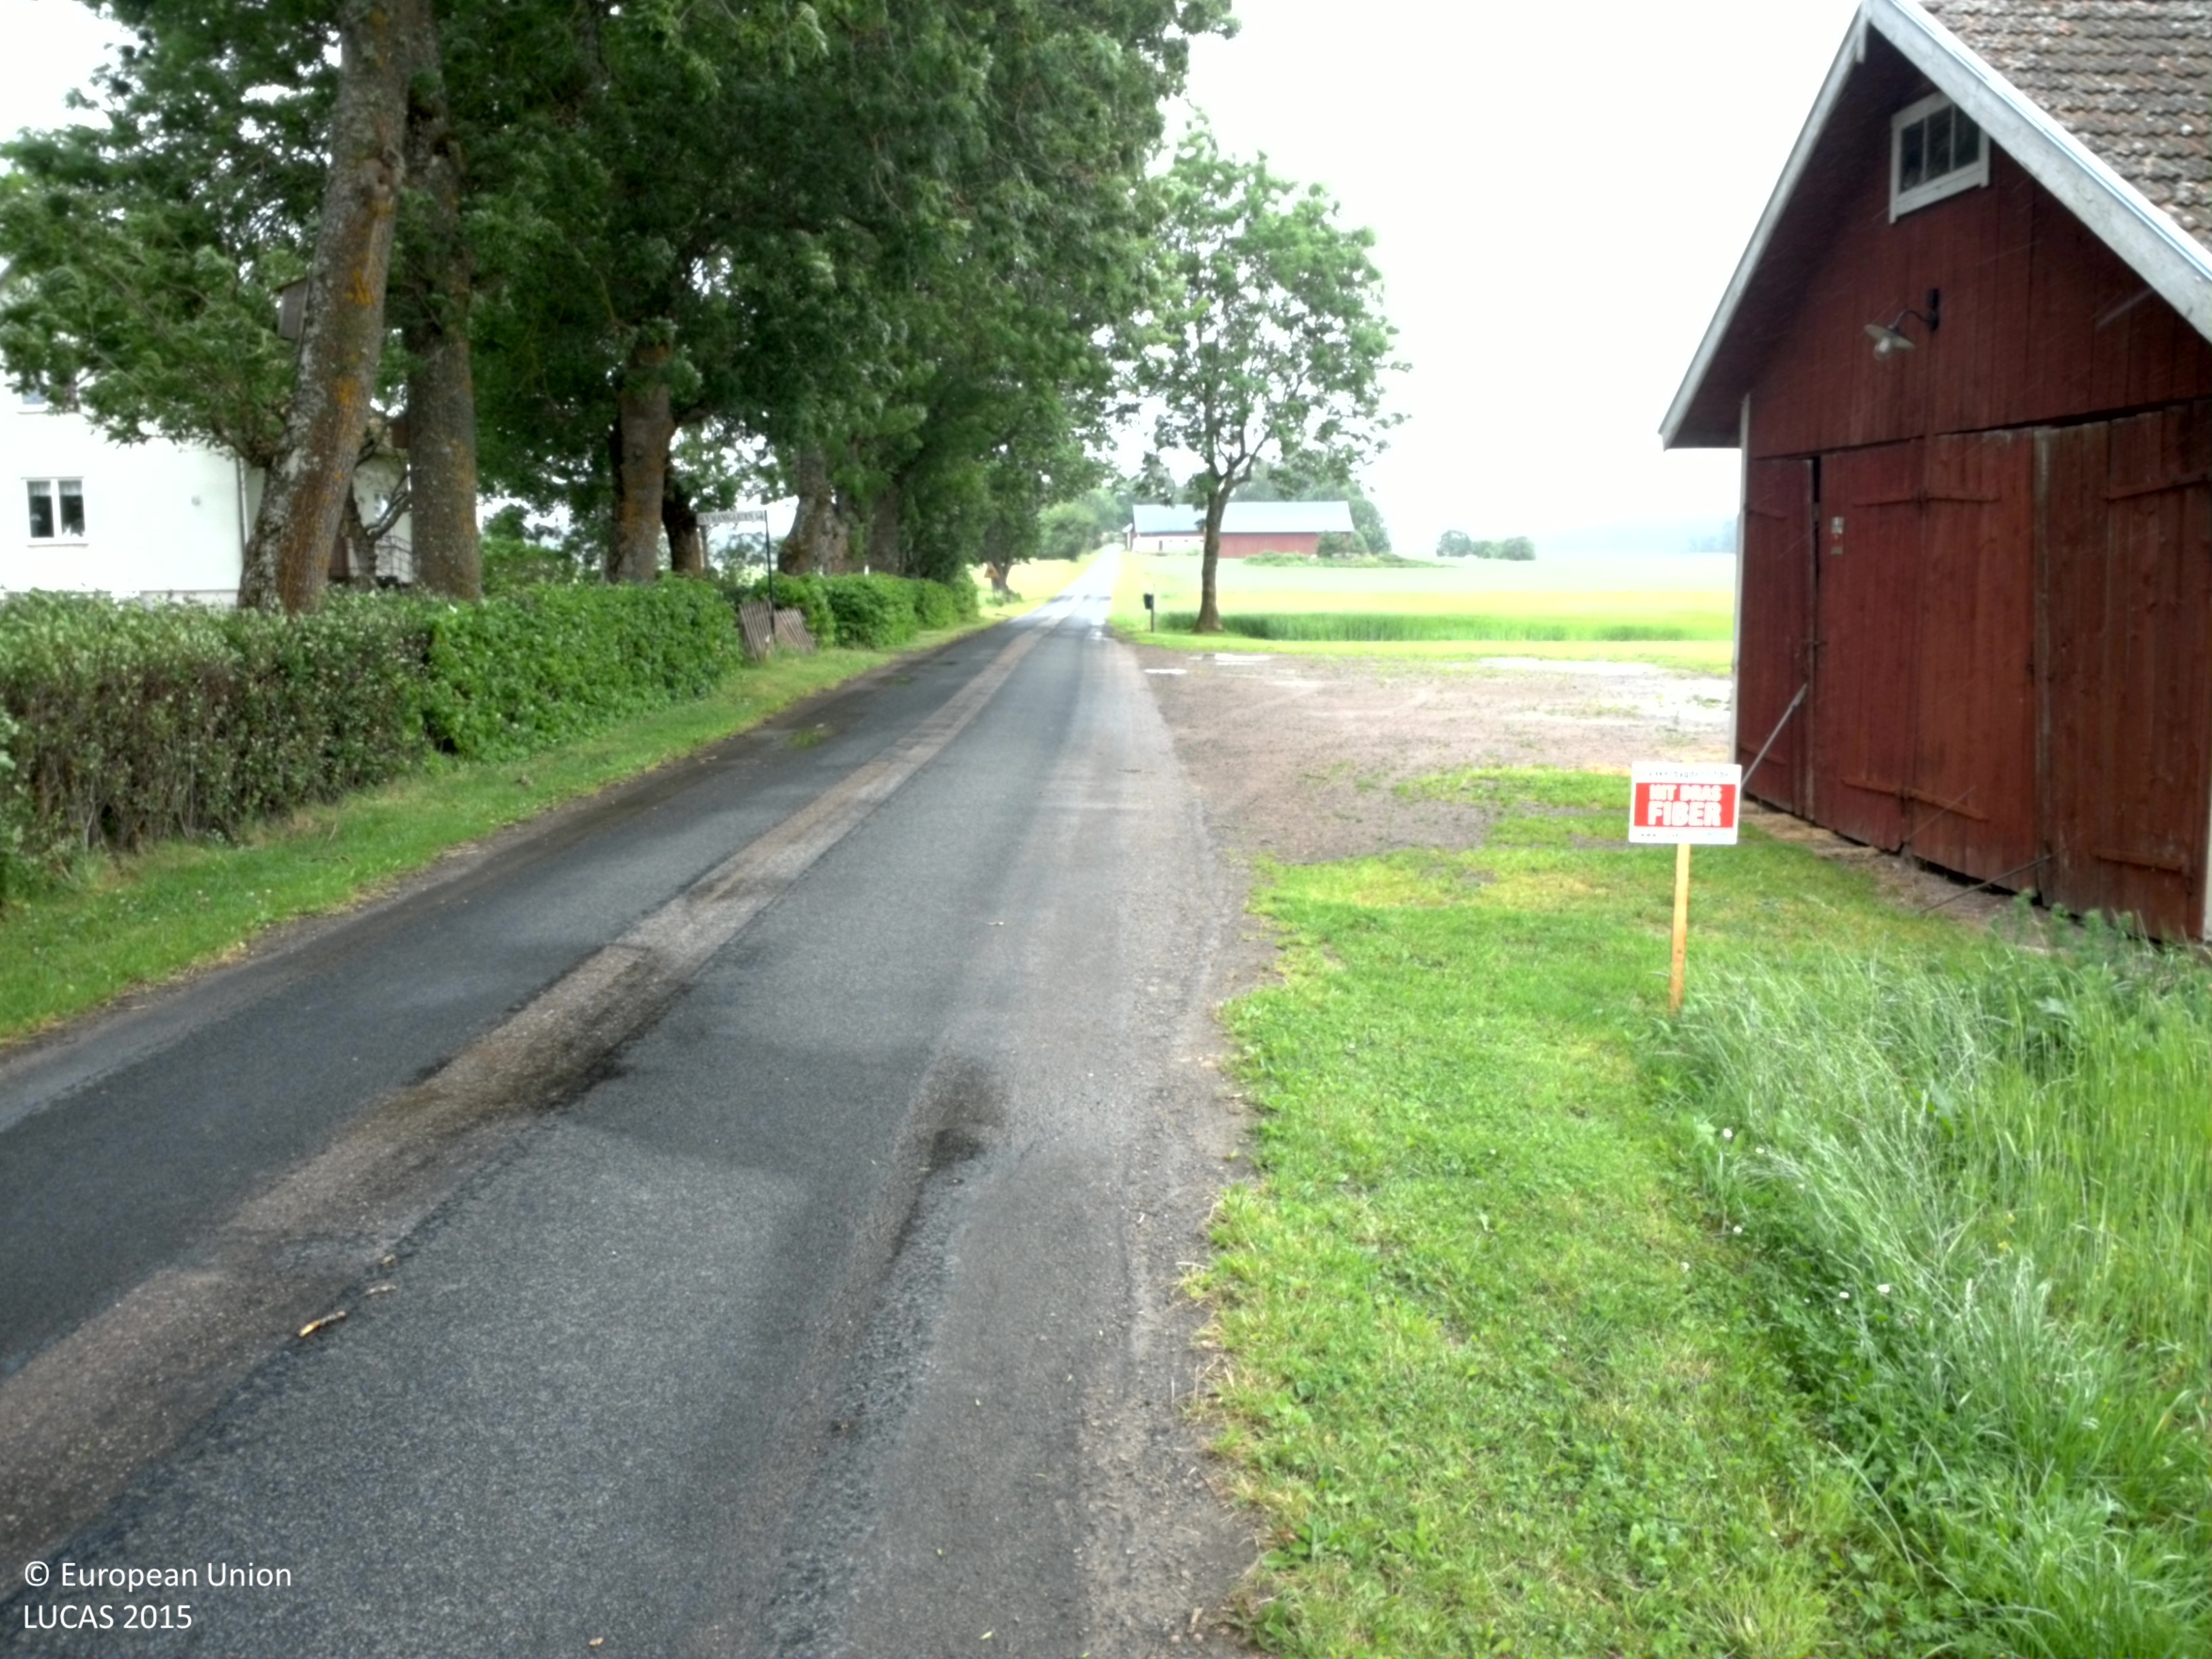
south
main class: Cropland
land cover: Barley
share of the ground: > 75 %
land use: Agriculture (excluding fallow land and kitchen gardens)
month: July
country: SE
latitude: 58.5045
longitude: 13.9235
